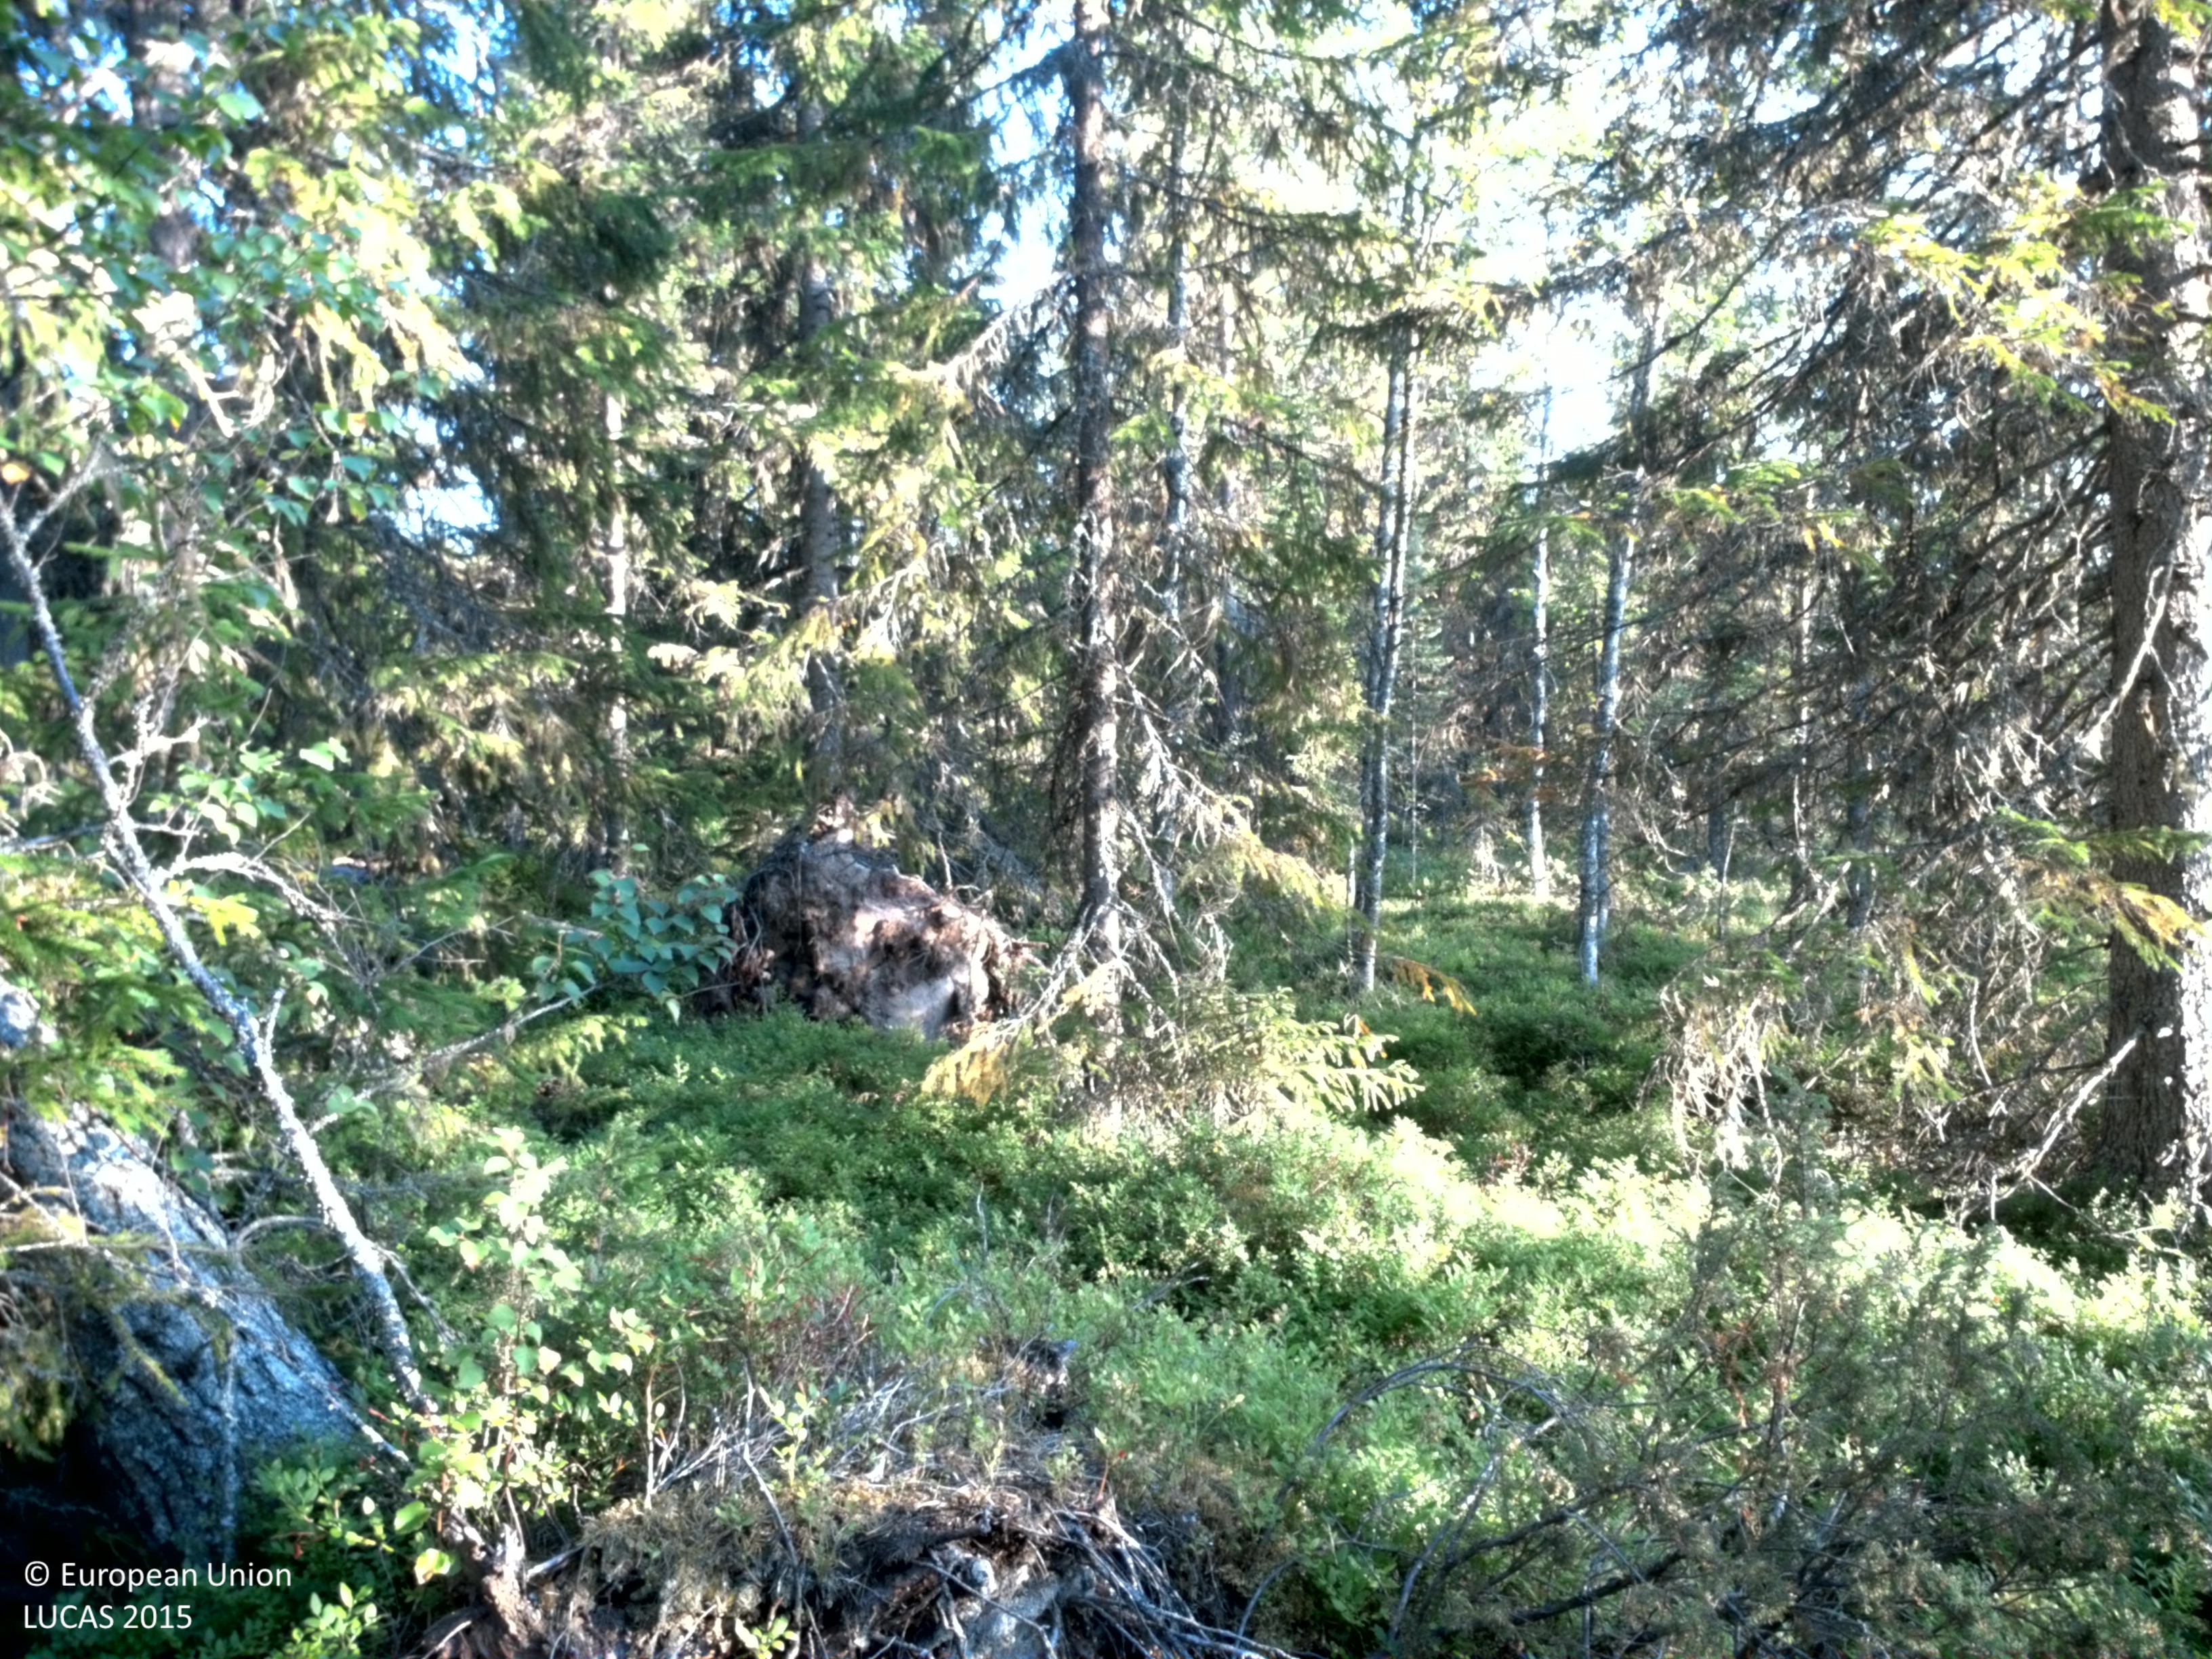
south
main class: Woodland
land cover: Spruce dominated coniferous woodland
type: boreal forest
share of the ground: 50 - 75 %
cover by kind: coniferous forest trees 65 %, shrubs 25 %, lichens and mosses 10 %
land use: Forestry
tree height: > 5 m
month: August
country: SE
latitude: 61.8551
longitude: 15.1708
